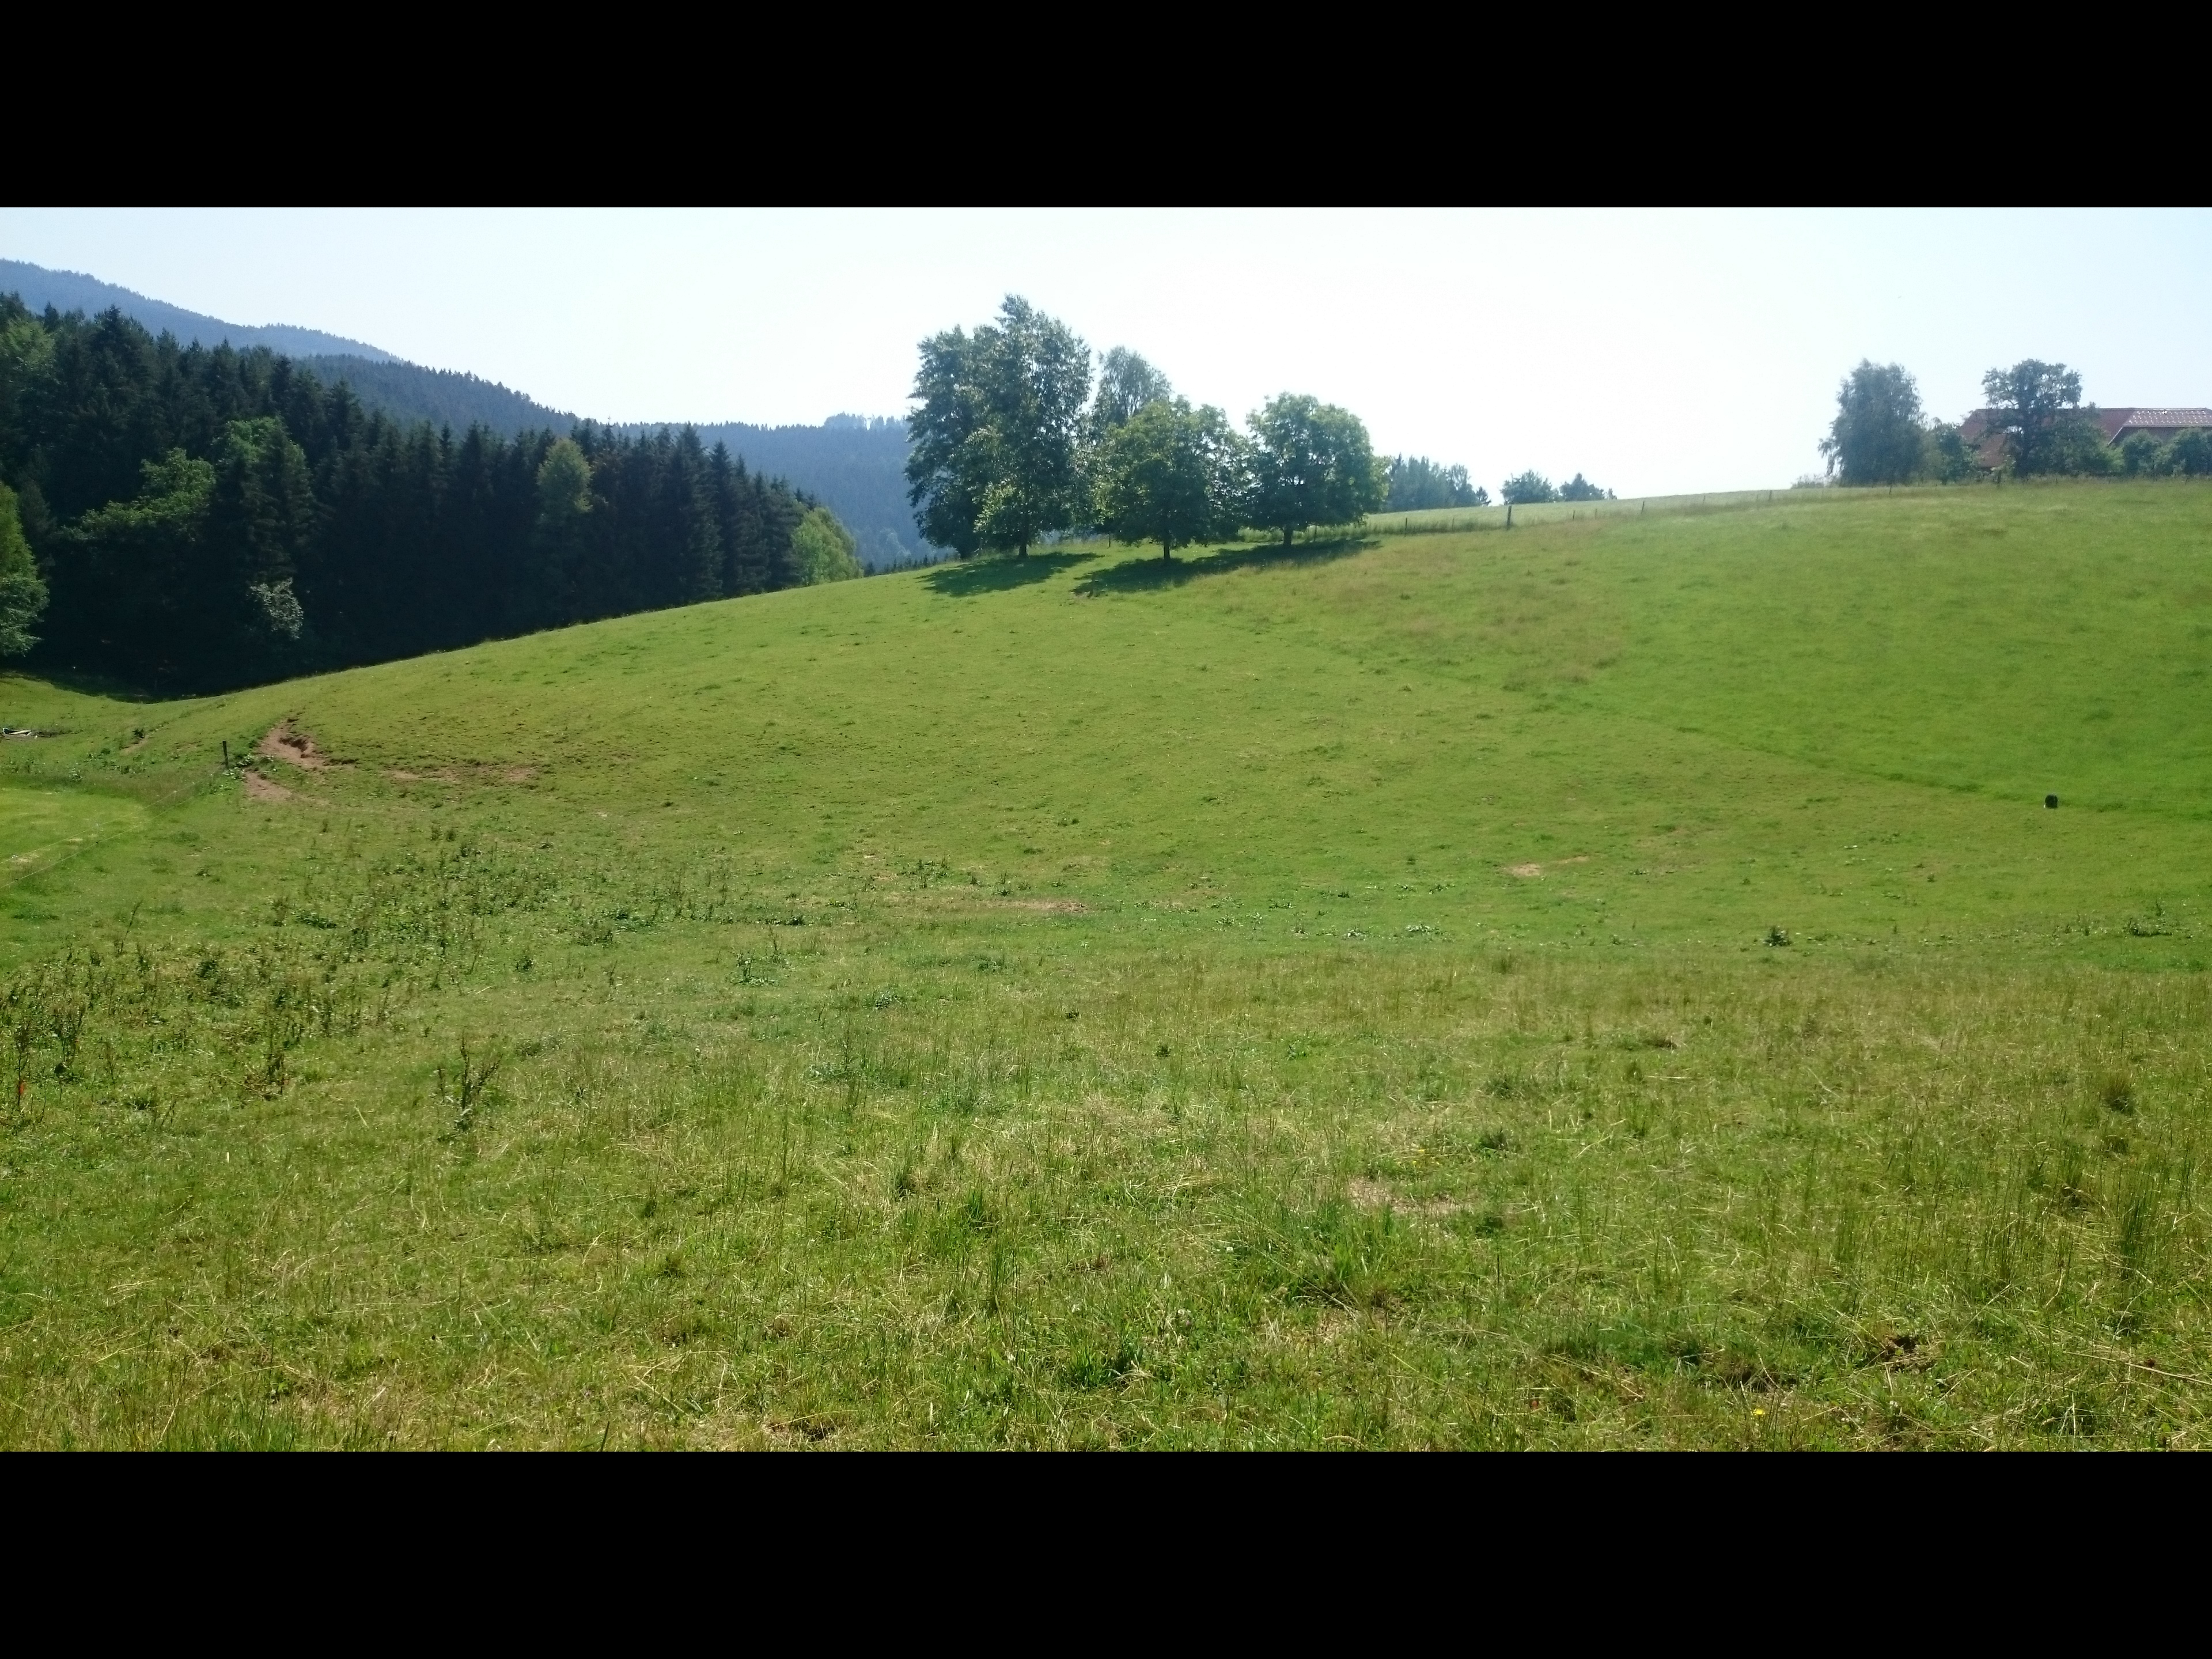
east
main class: Grassland
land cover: Grassland without tree/shrub cover
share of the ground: > 75 %
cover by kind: herbaceous plants 100 %
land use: Agriculture (excluding fallow land and kitchen gardens)
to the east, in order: Grassland without tree/shrub cover; Fences; Grassland without tree/shrub cover; Spruce dominated mixed woodland
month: June
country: AT
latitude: 48.3965
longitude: 14.6334
